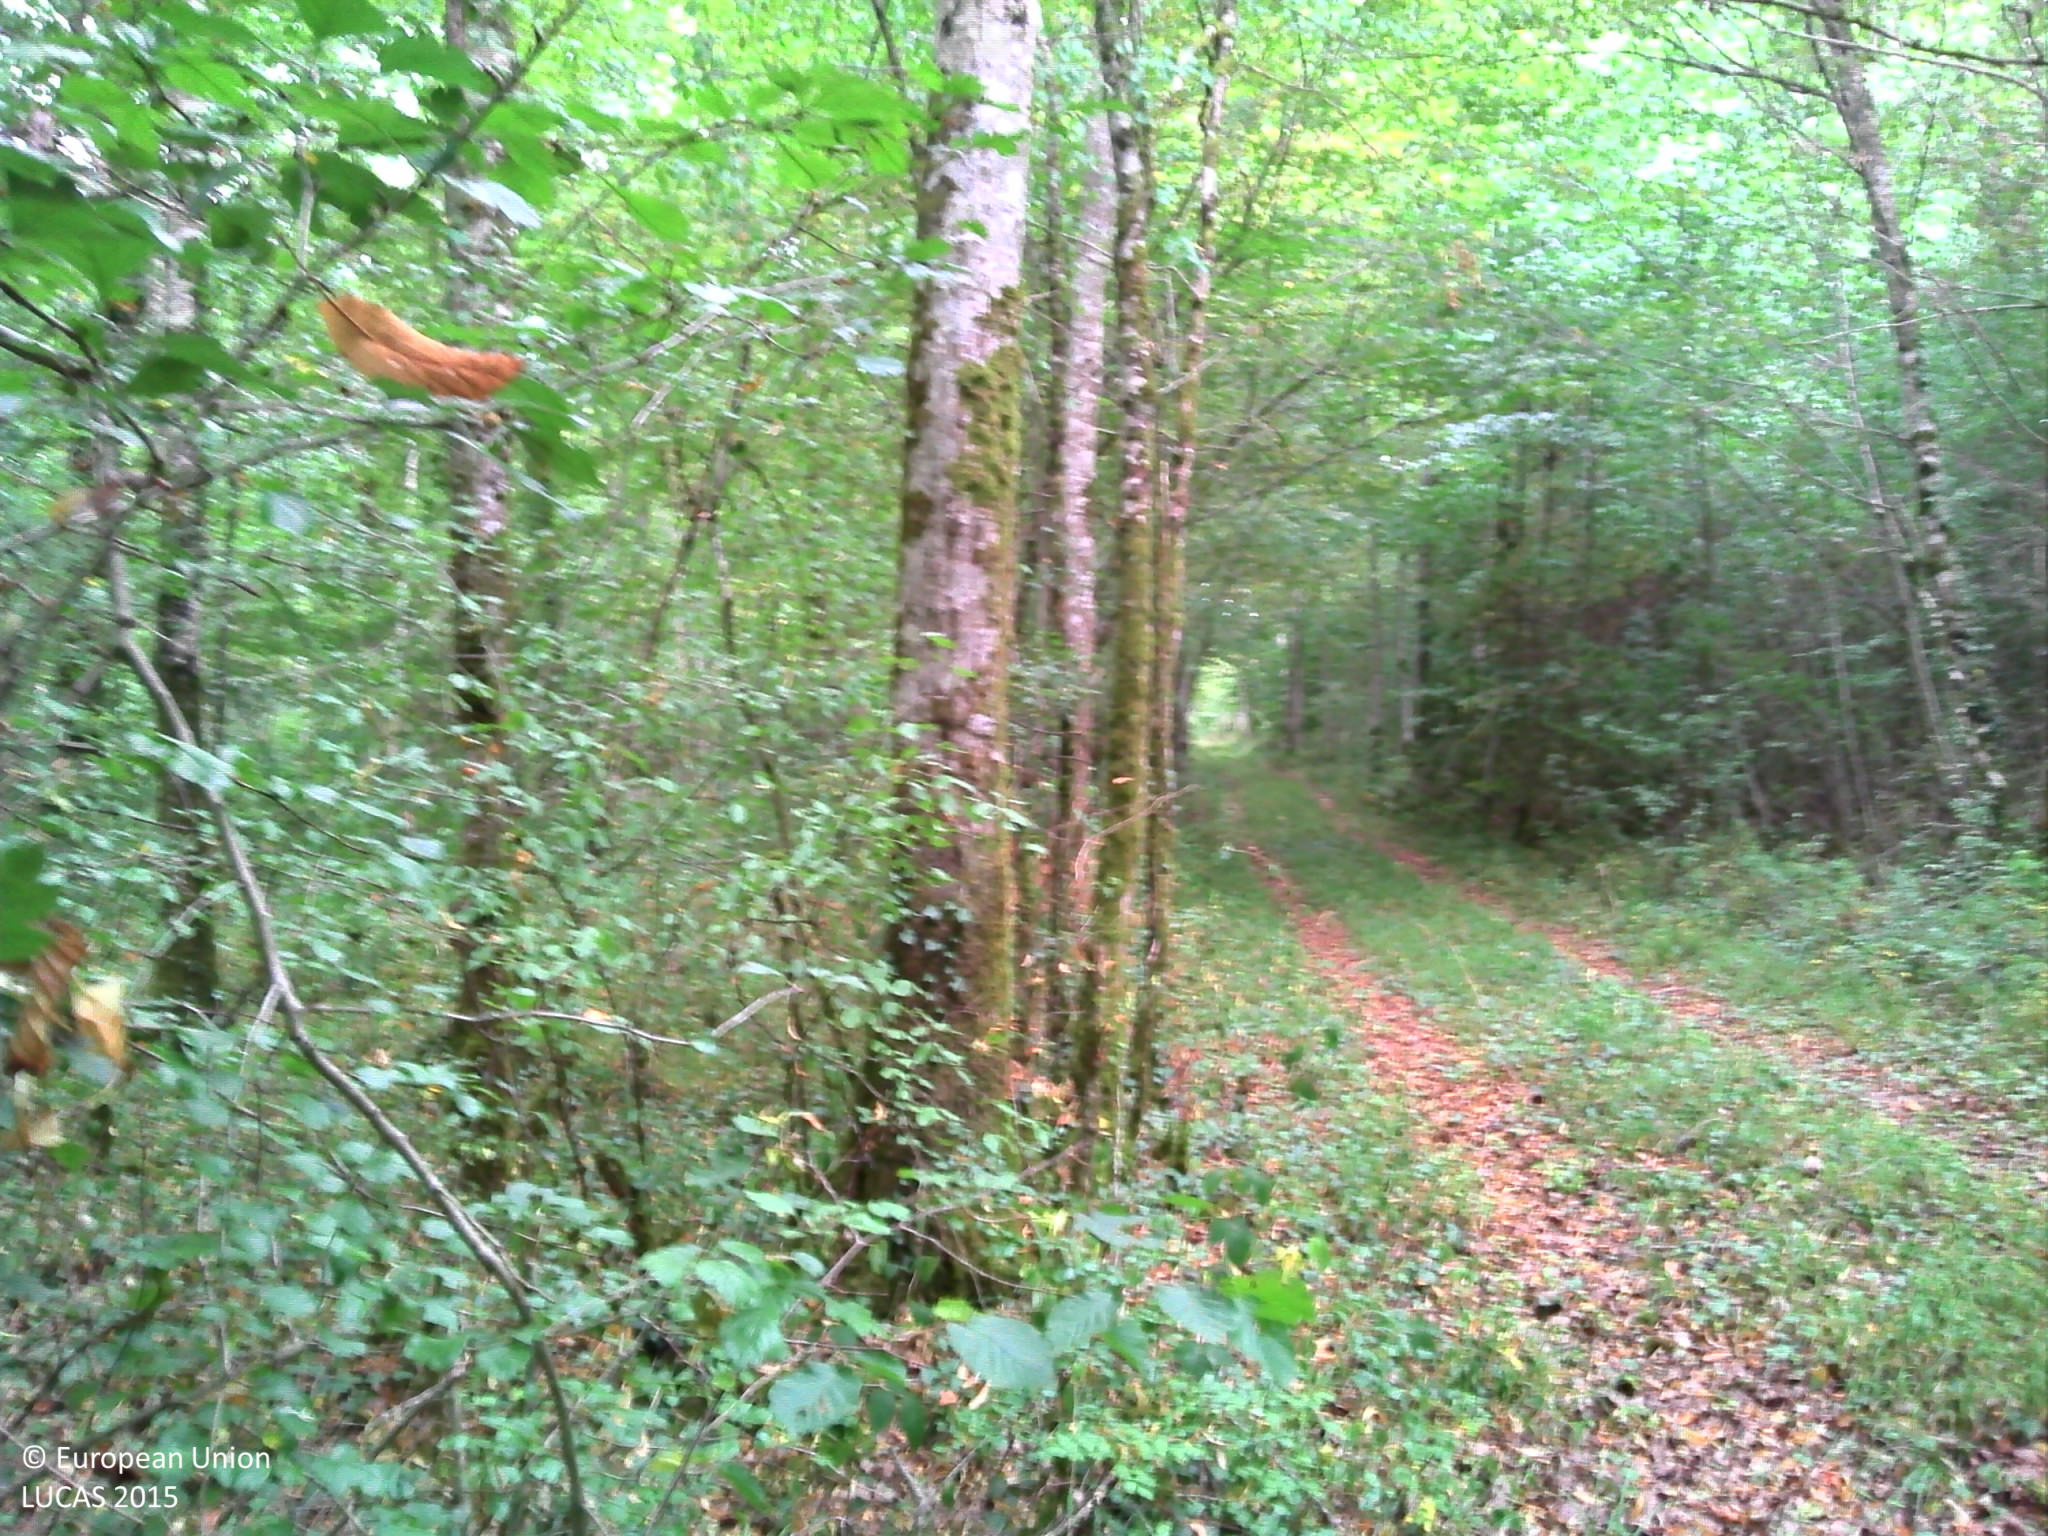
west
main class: Woodland
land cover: Broadleaved woodland
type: mesophytic deciduous forest
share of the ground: > 75 %
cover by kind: broadleaved forest trees 80 %, herbaceous plants 10 %, lichens and mosses 10 %
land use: Forestry
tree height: > 5 m
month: July
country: FR
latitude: 47.9408
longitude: 5.2472
